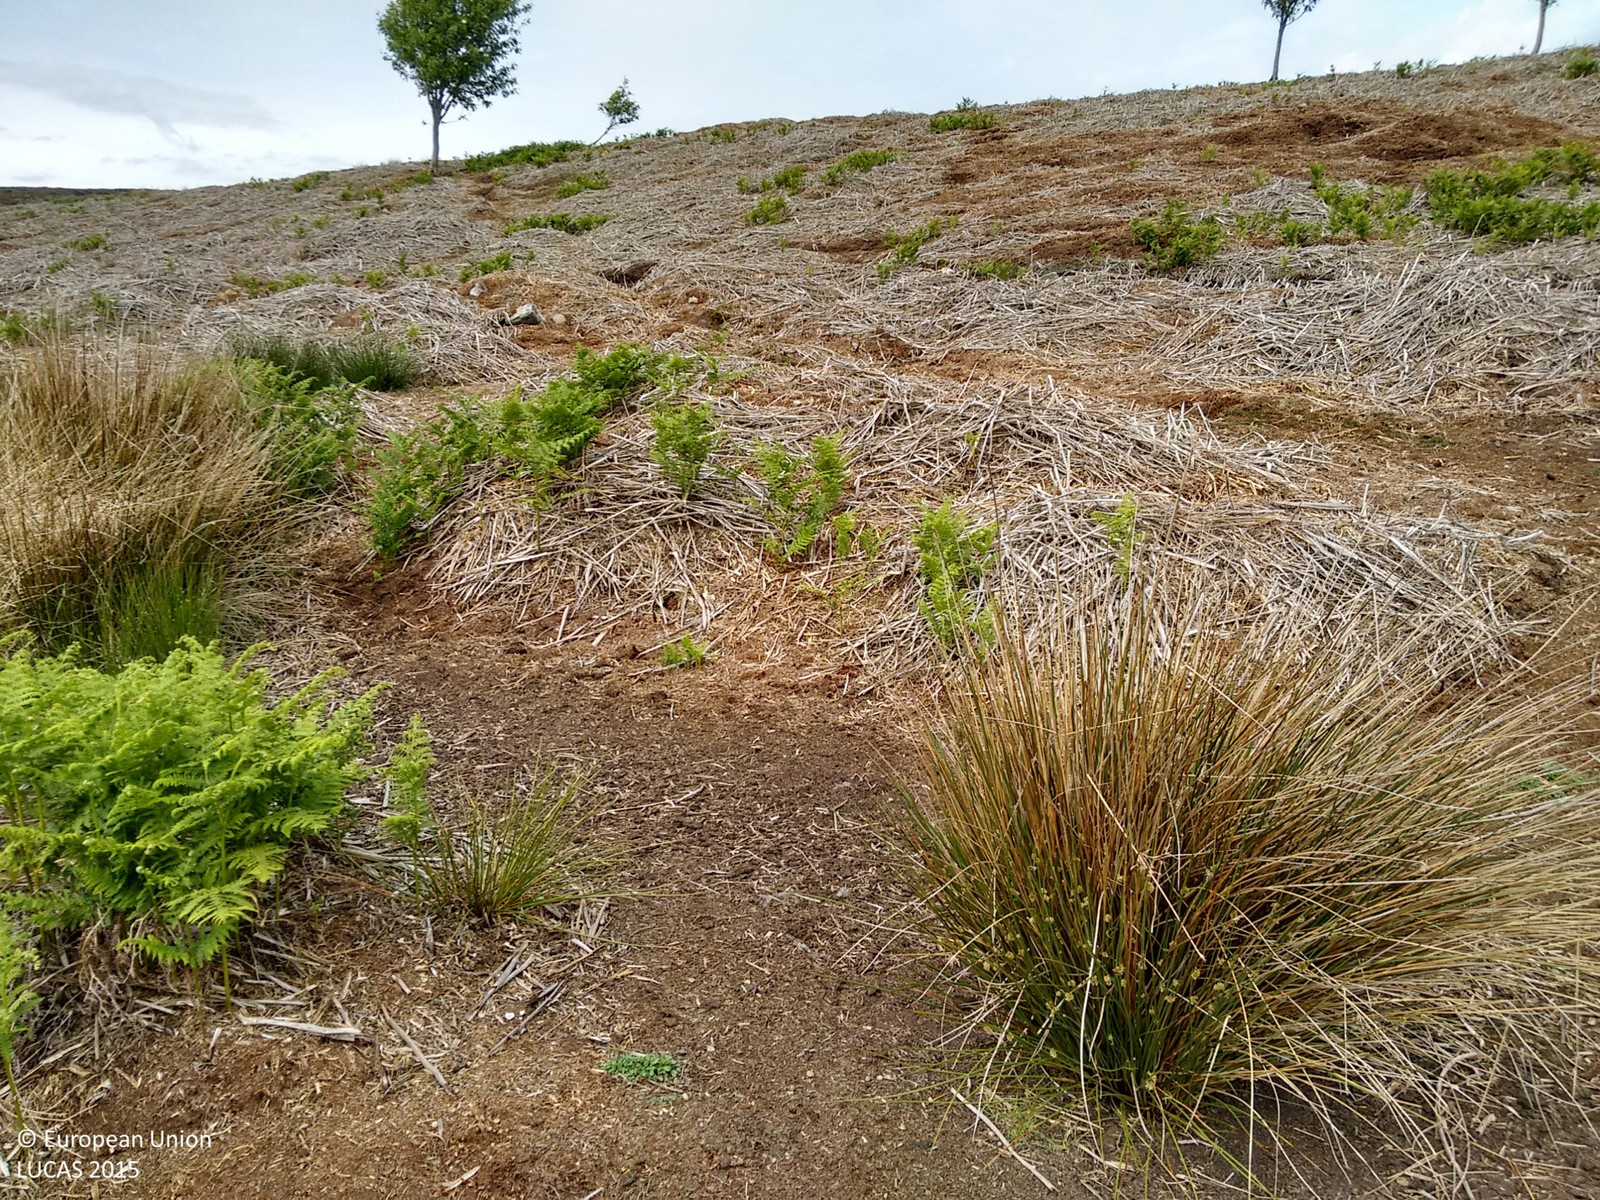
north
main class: Grassland
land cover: Grassland without tree/shrub cover
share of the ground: > 75 %
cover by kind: herbaceous plants 100 %
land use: Agriculture (excluding fallow land and kitchen gardens)
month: June
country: GB
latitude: 54.3488
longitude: -1.2297
